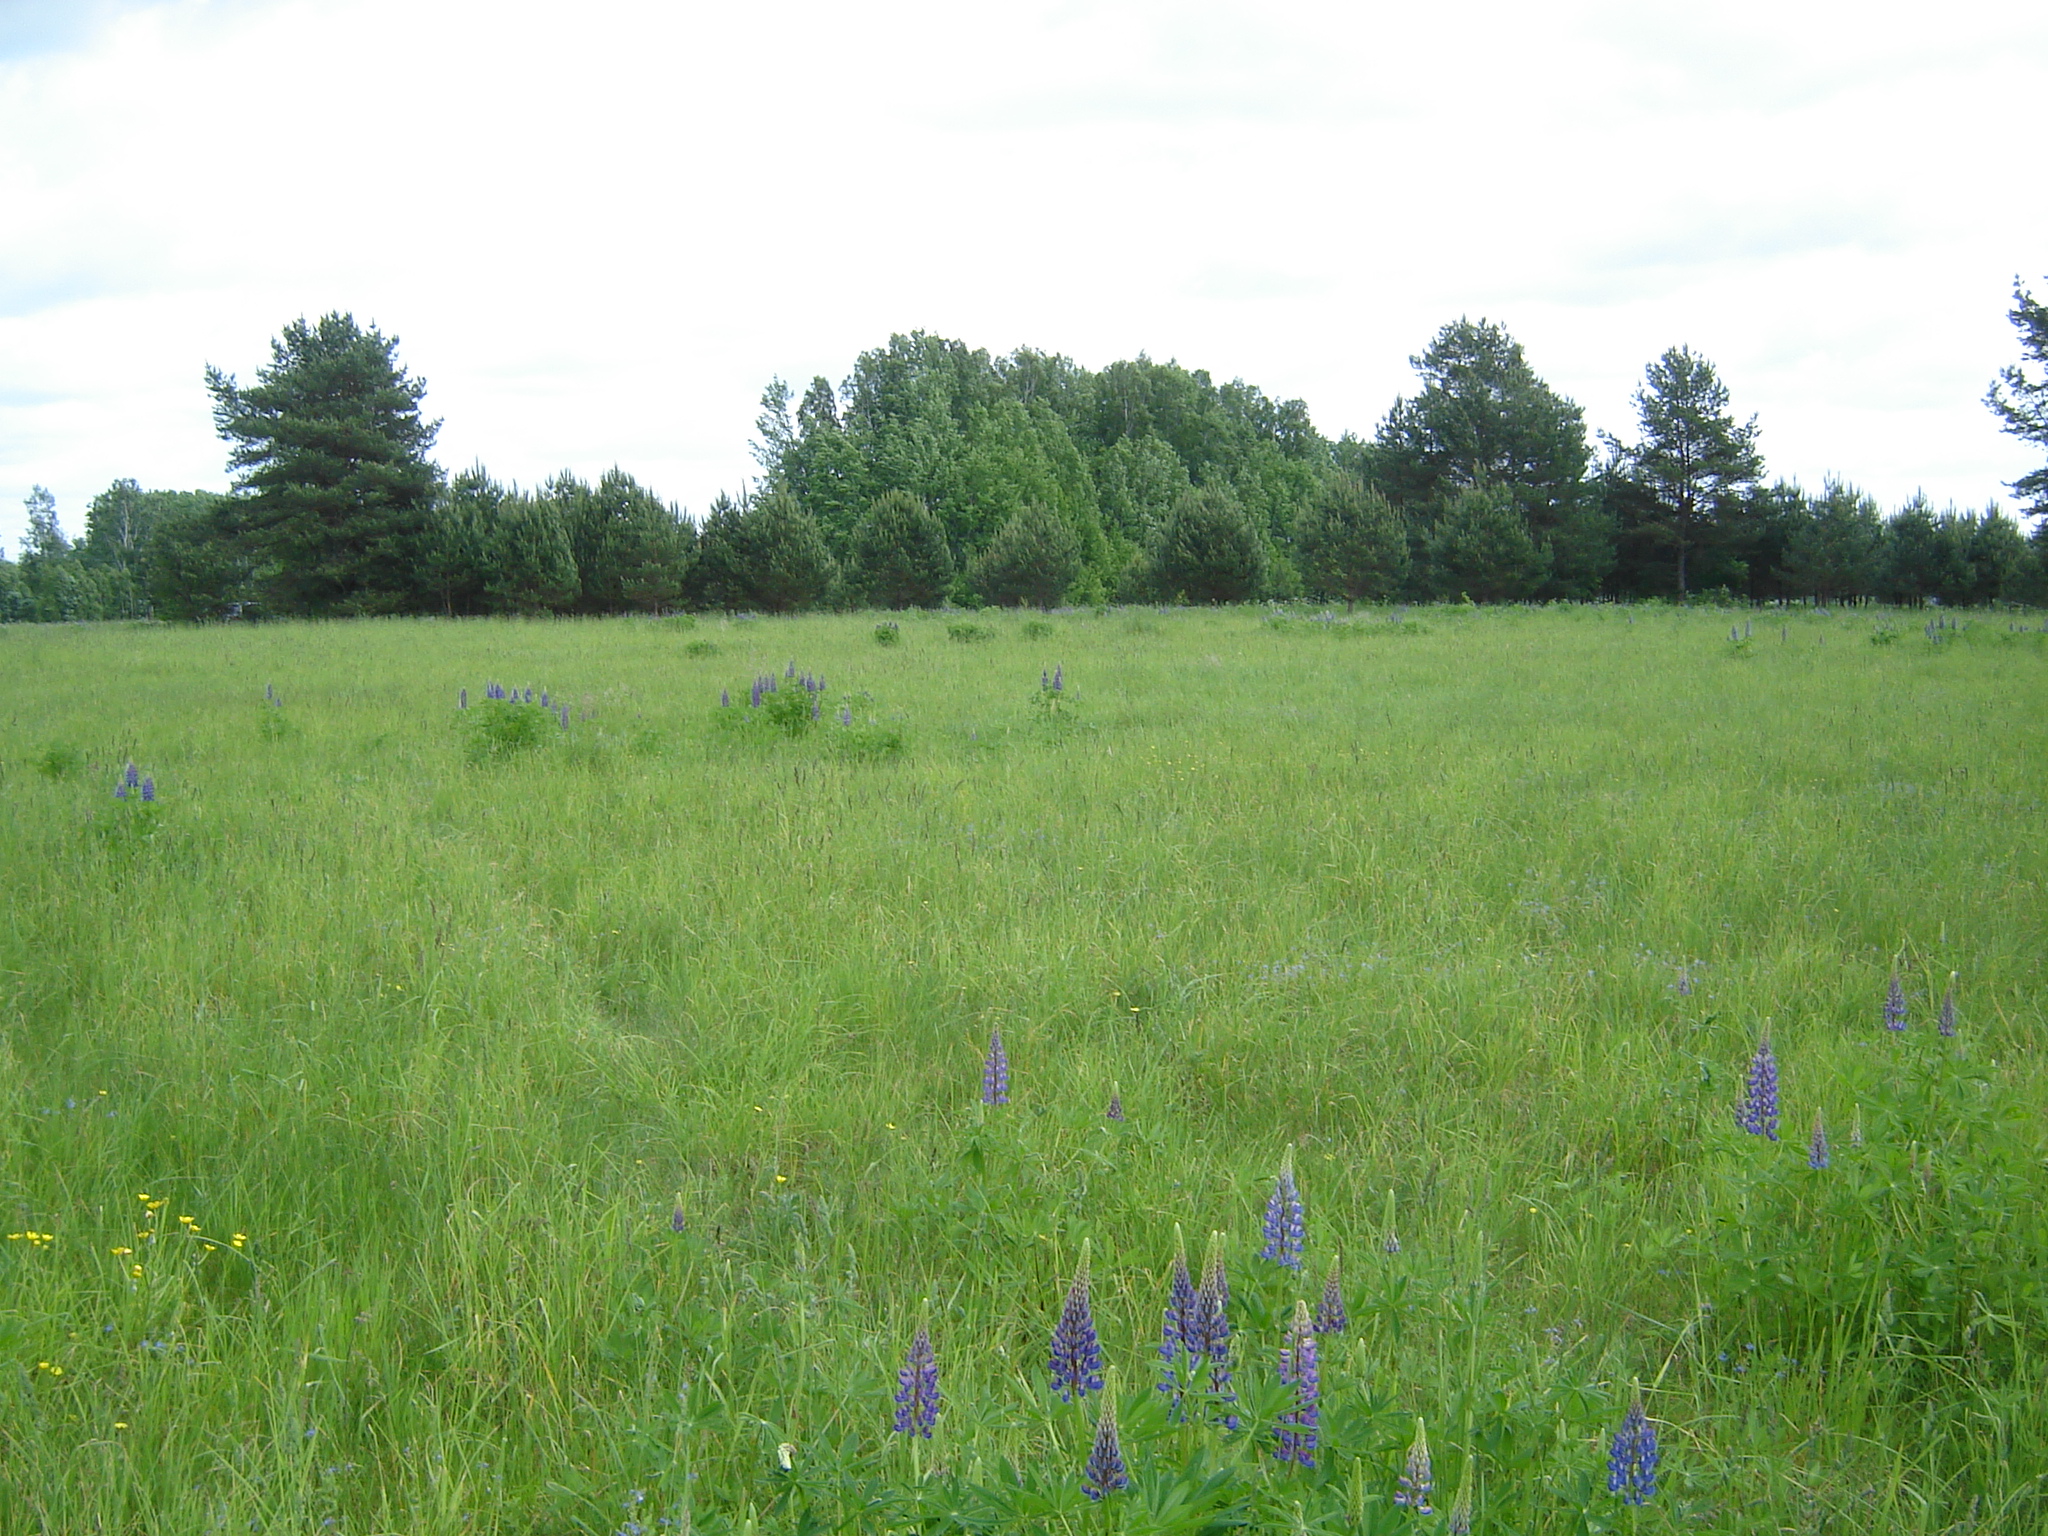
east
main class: Grassland
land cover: Grassland without tree/shrub cover
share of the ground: > 75 %
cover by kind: herbaceous plants 100 %
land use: Agriculture (excluding fallow land and kitchen gardens)
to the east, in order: Grassland without tree/shrub cover; Pine dominated coniferous woodland; Grassland without tree/shrub cover; Tracks; Lines of trees; Grassland without tree/shrub cover; Broadleaved woodland; Grassland without tree/shrub cover; Electric lines; Grassland without tree/shrub cover
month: June
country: LT
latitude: 55.6350
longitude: 25.5496
